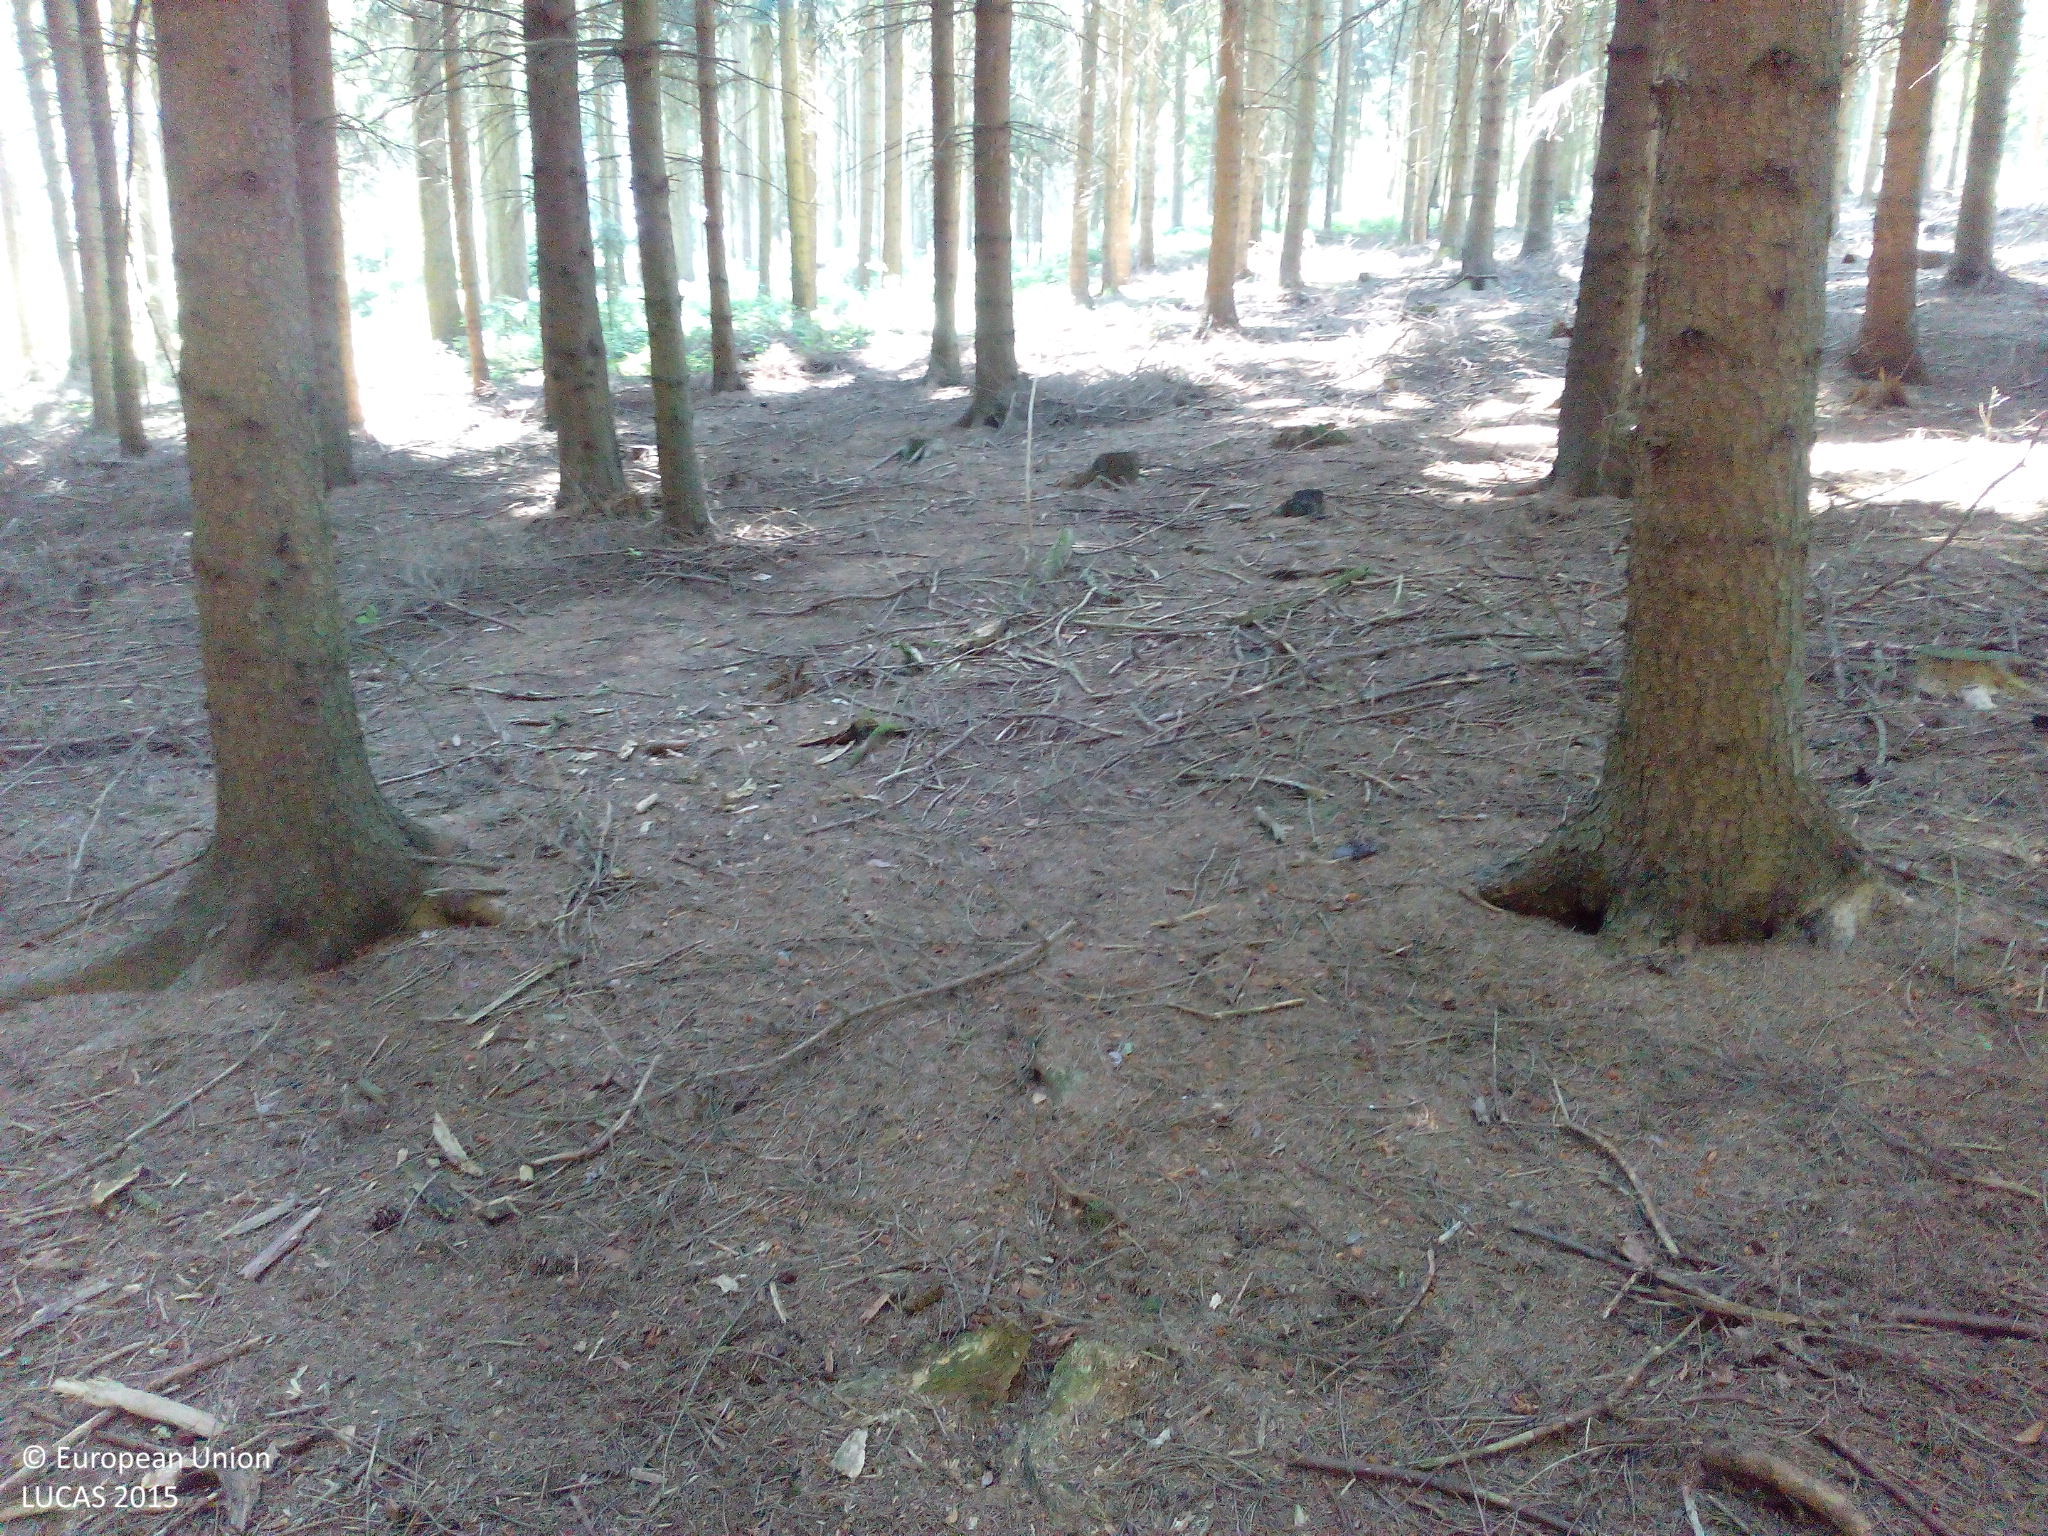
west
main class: Woodland
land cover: Spruce dominated coniferous woodland
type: hemiboreal forest and nemoral coniferous forest and mixed broadleaved-coniferous forest
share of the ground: > 75 %
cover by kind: coniferous forest trees 95 %, unconsolidated bare surface 5 %
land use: Forestry
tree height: > 5 m
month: June
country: DE
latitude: 48.6540
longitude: 12.0762
